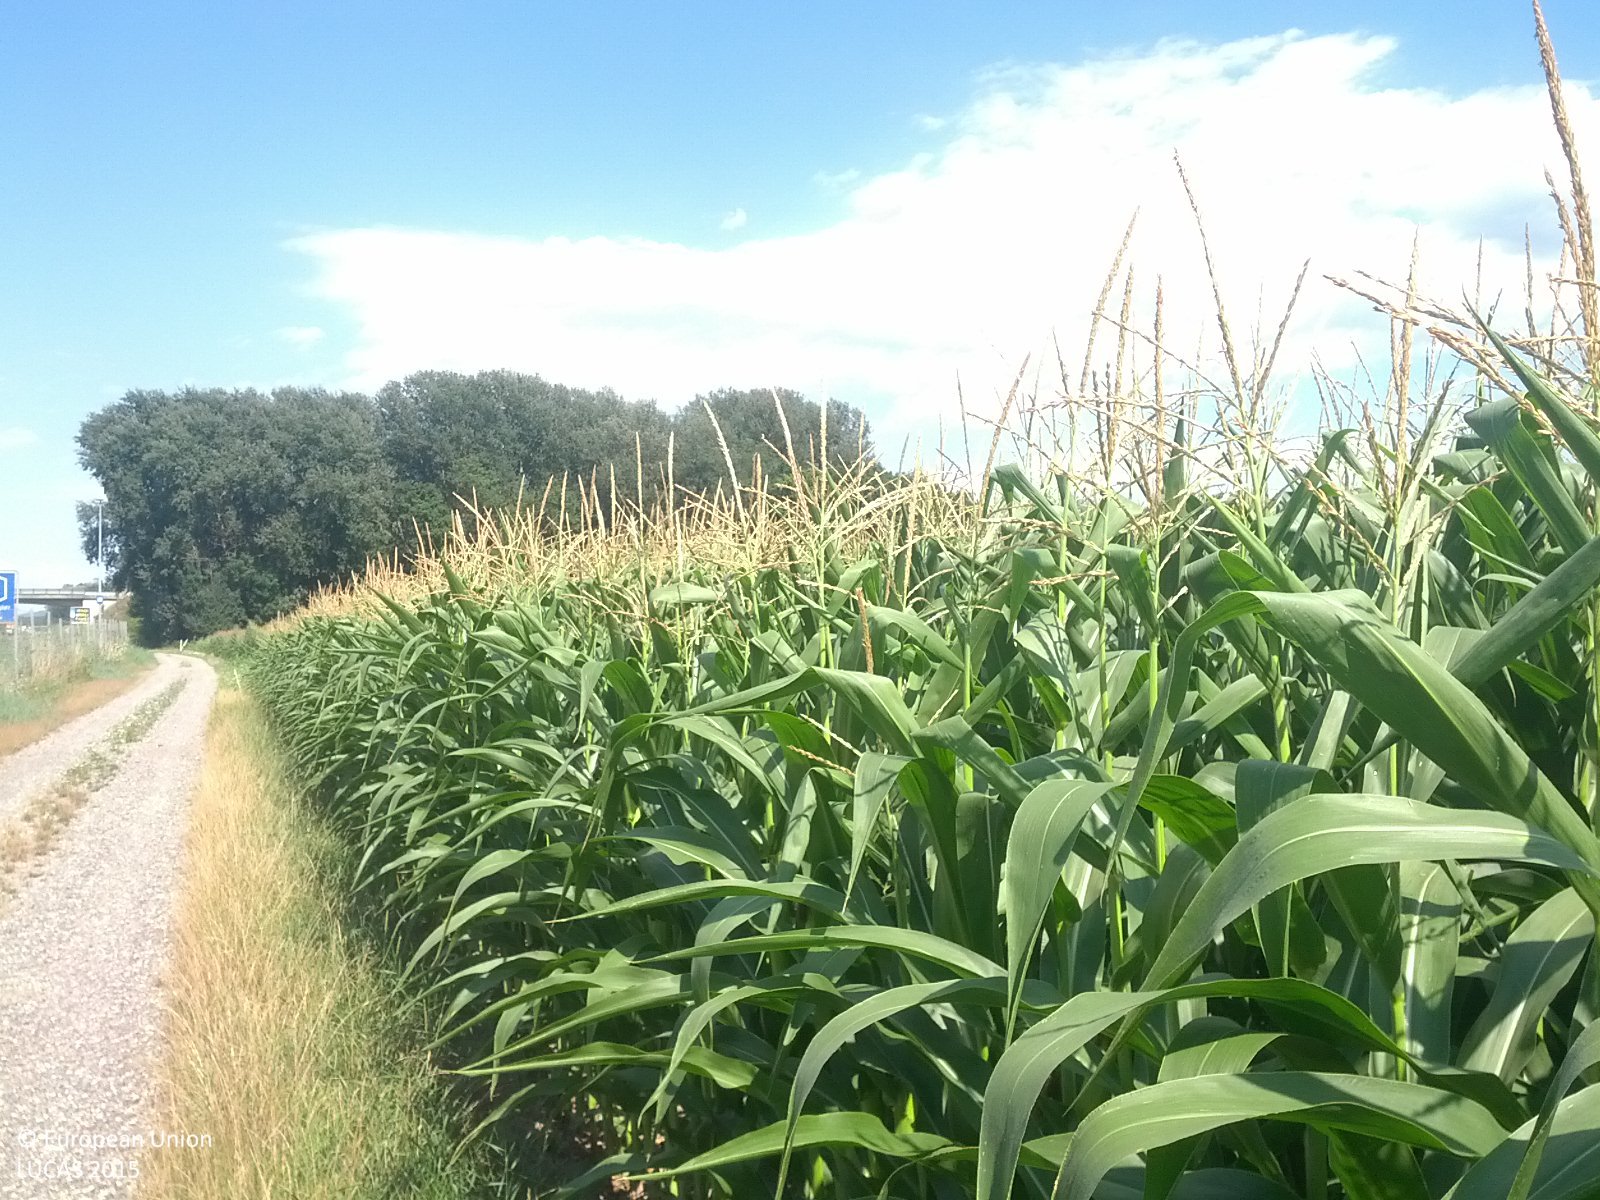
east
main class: Cropland
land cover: Maize
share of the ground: > 75 %
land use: Agriculture (excluding fallow land and kitchen gardens)
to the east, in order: Grass margins; Maize; Sugar beet; Maize; Fences; Tracks; Broadleaved woodland; Grassland without tree/shrub cover
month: July
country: AT
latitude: 48.3618
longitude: 16.0915
